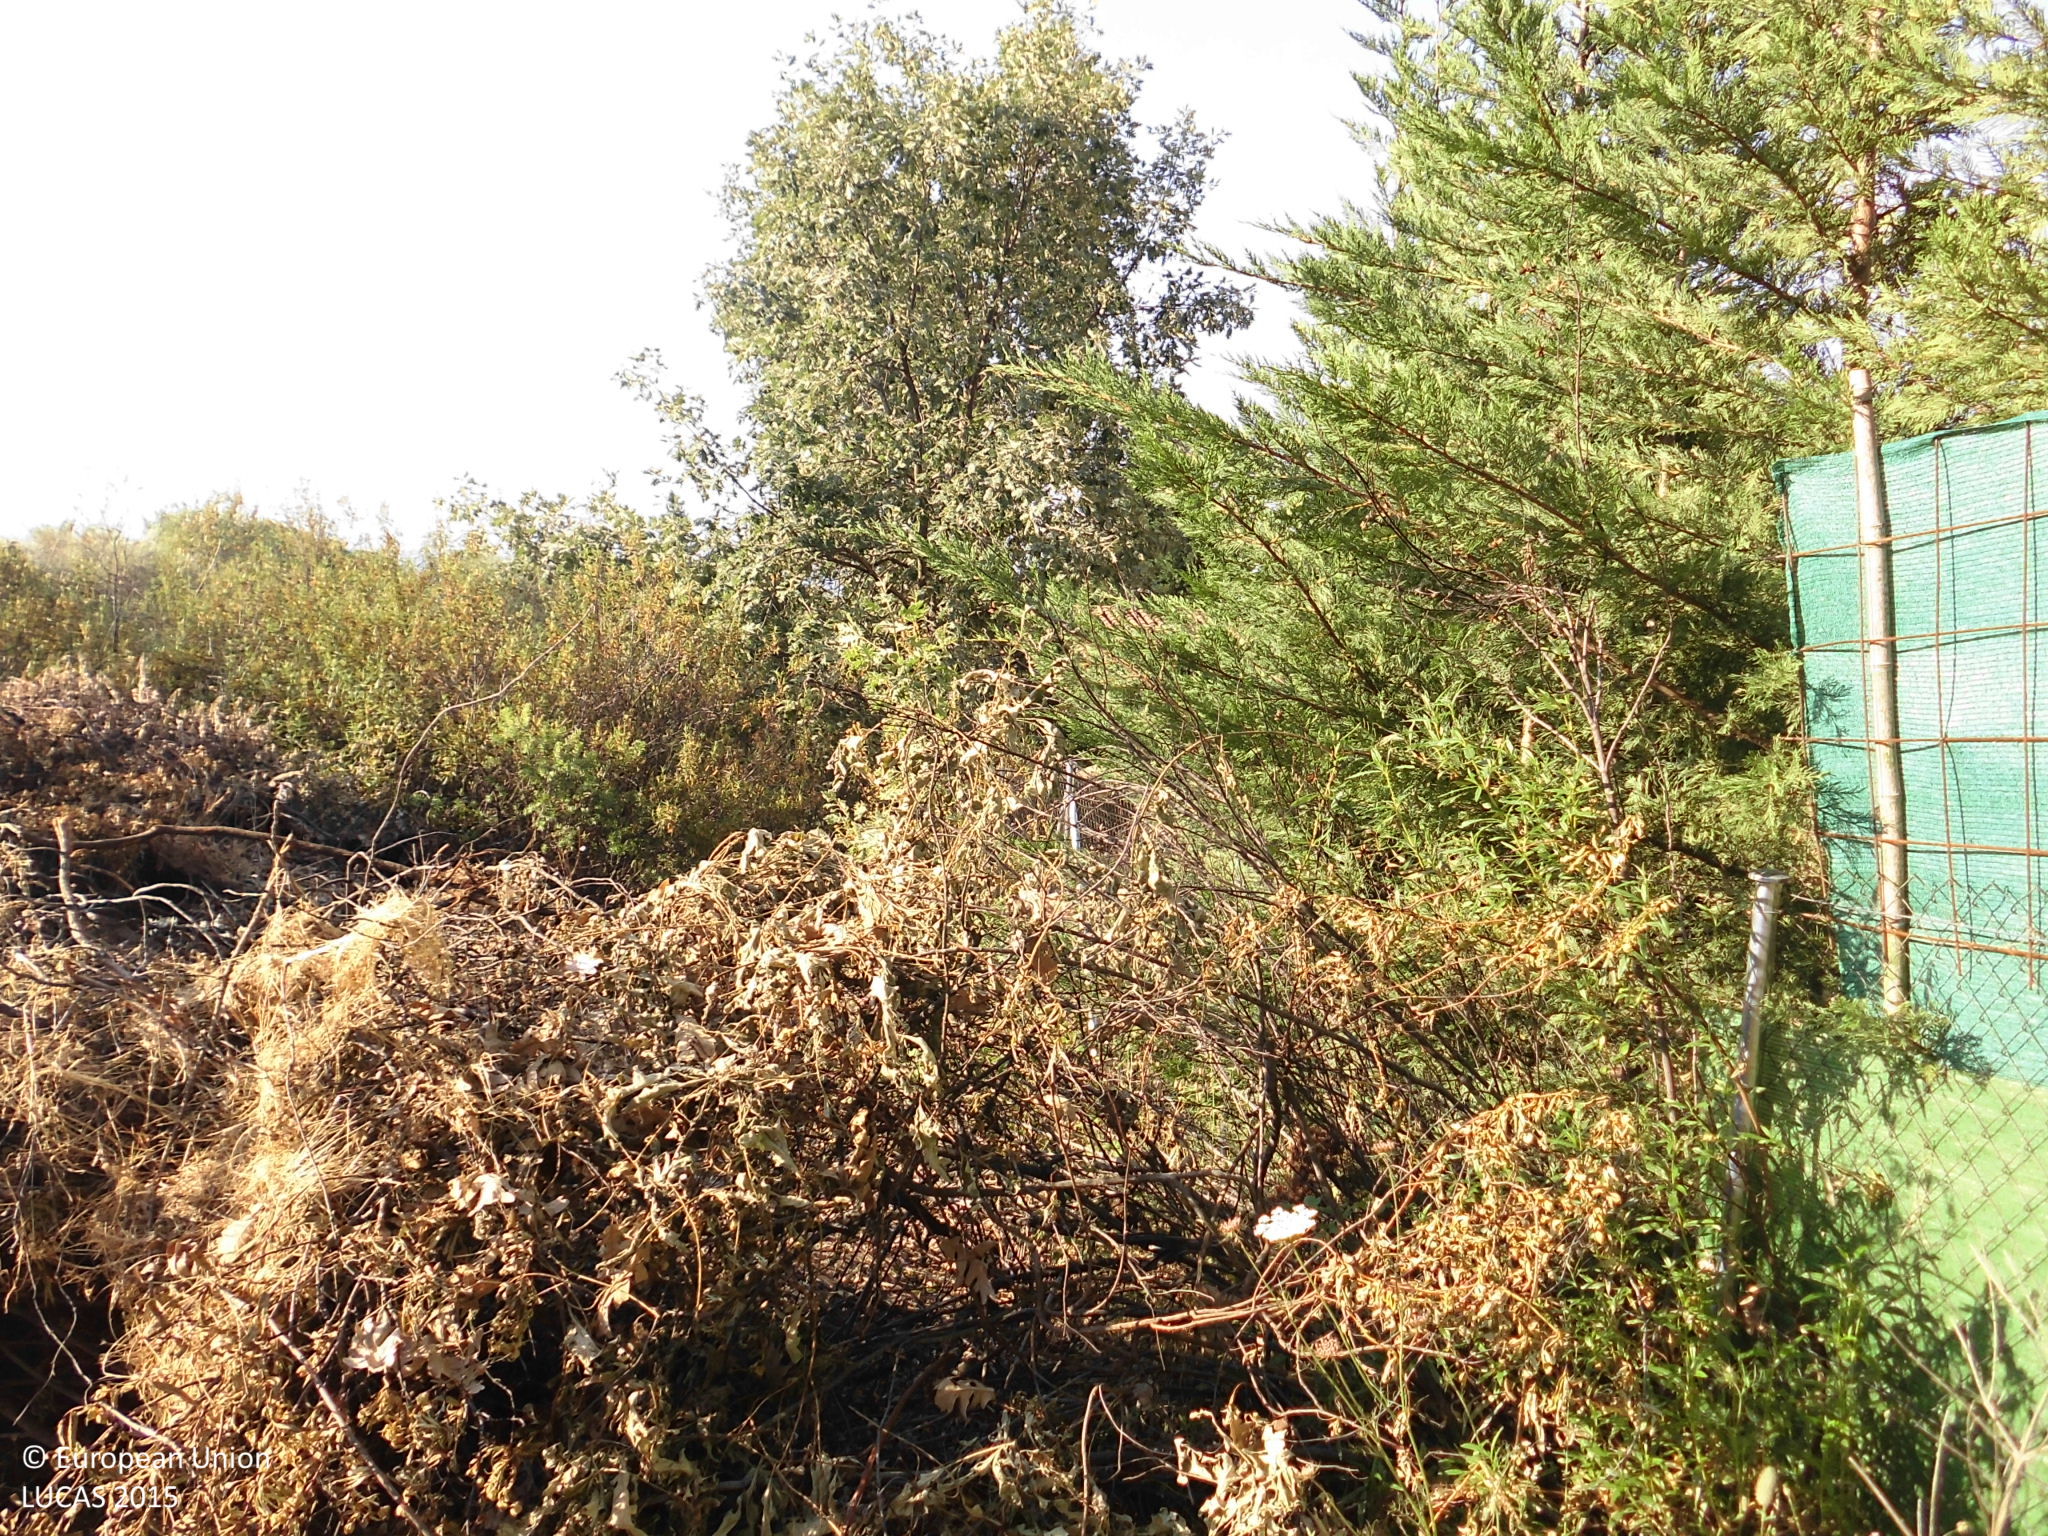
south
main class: Shrubland
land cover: Shrubland with sparse tree cover
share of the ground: > 75 %
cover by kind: shrubs 75 %, herbaceous plants 20 %, broadleaved forest trees 5 %
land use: Residential
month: June
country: ES
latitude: 40.1383
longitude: -5.4481
